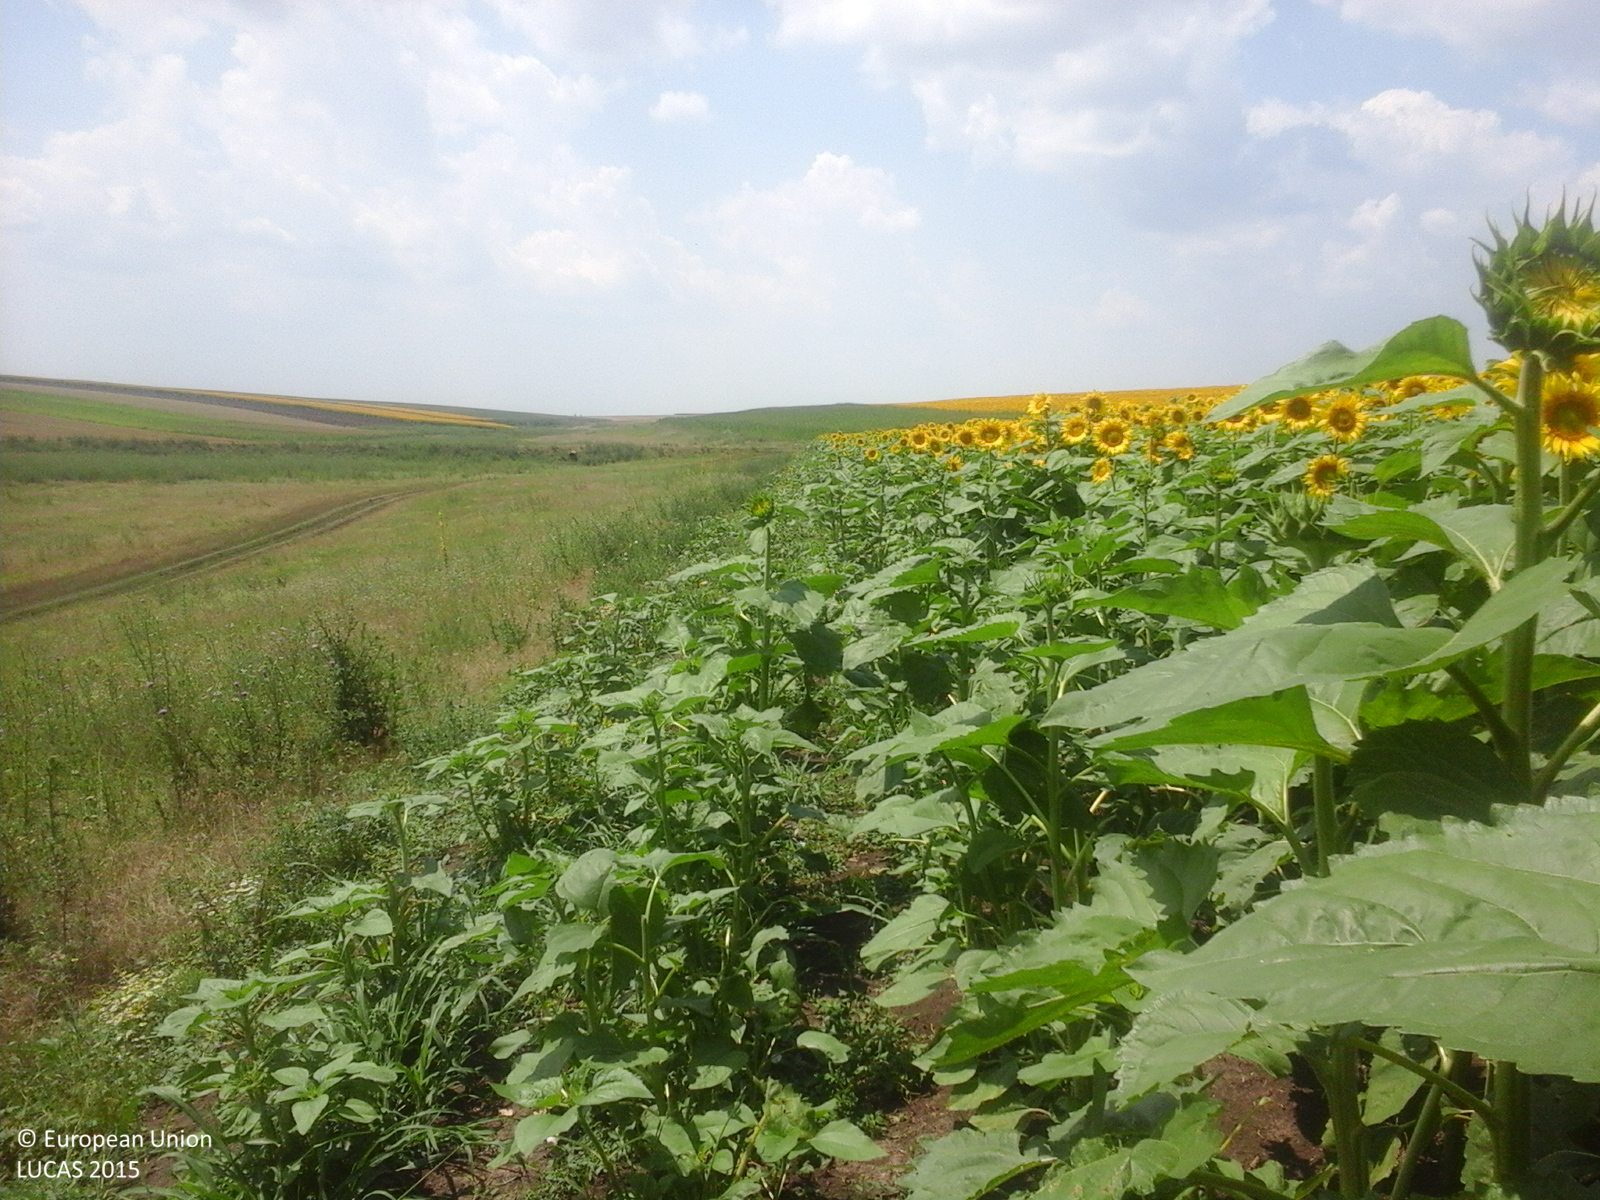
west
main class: Cropland
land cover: Sunflower
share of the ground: > 75 %
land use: Agriculture (excluding fallow land and kitchen gardens)
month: July
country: RO
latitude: 43.8928
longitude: 25.7387
